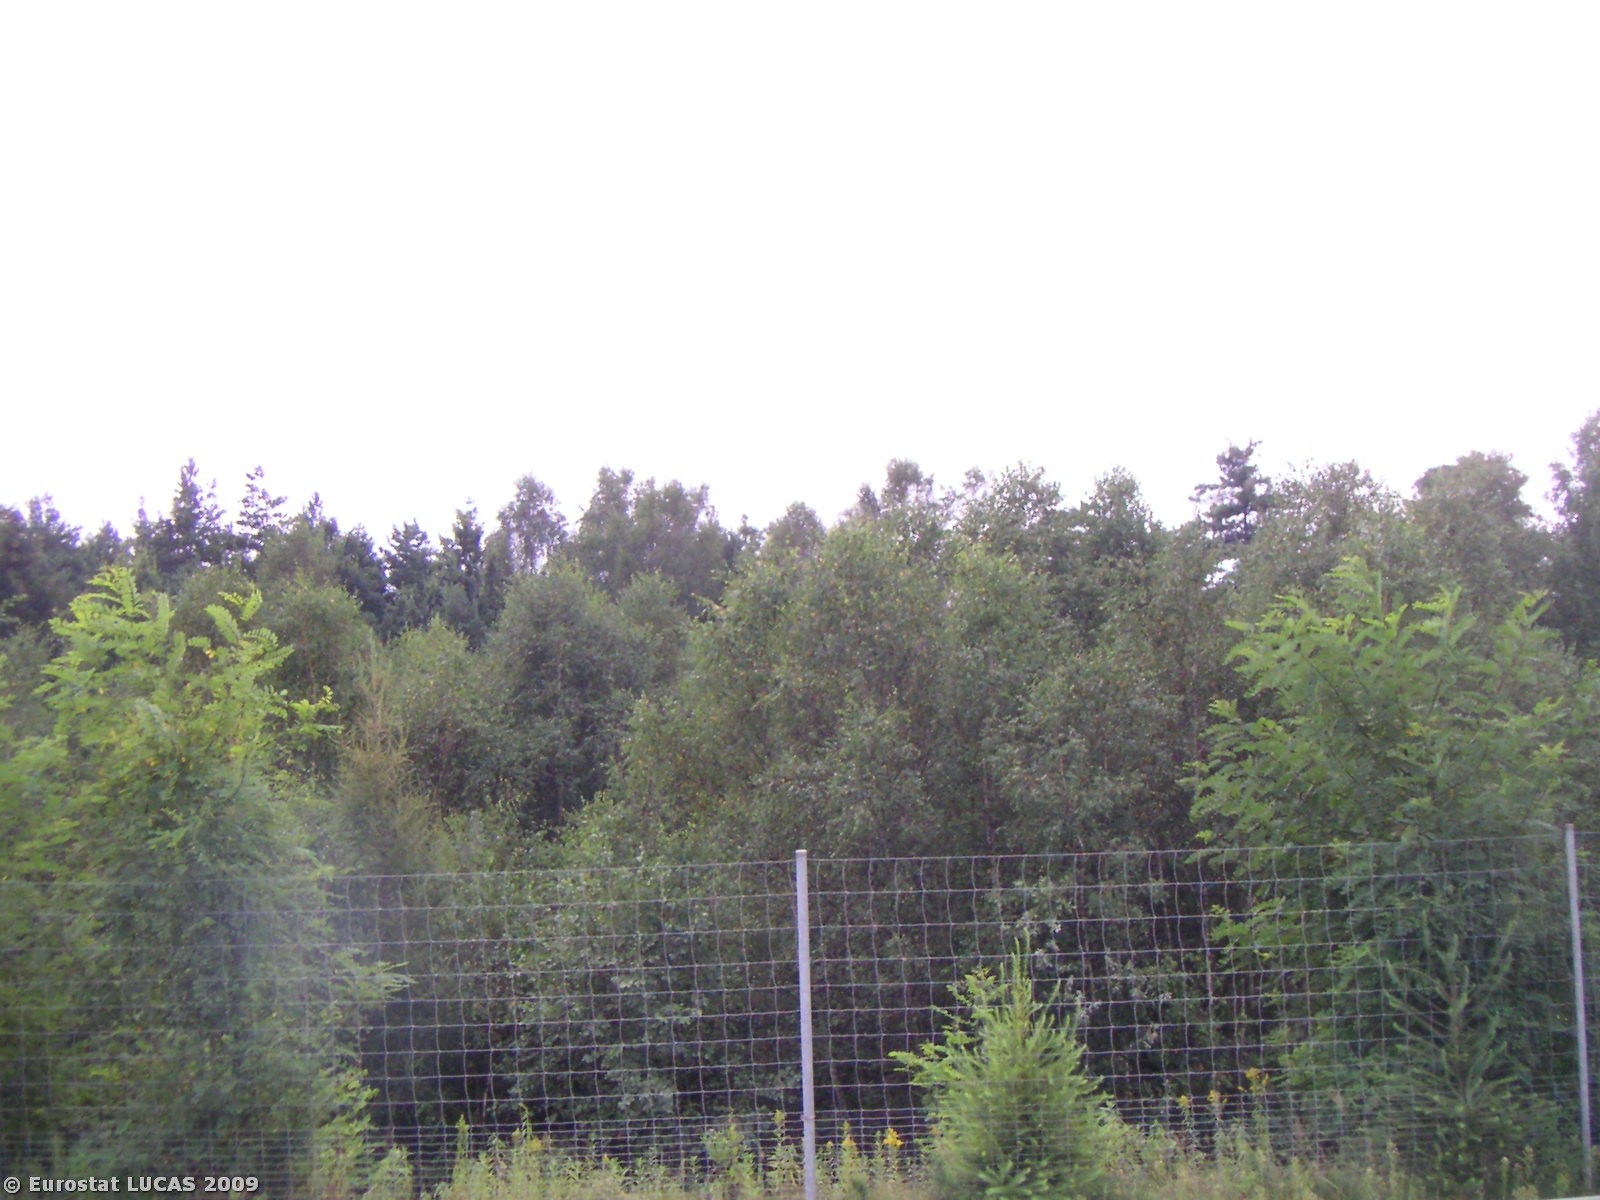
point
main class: Woodland
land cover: Mixed woodland
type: hemiboreal forest and nemoral coniferous forest and mixed broadleaved-coniferous forest
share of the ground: > 75 %
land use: Forestry
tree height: > 5 m
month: August
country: PL
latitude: 50.2583
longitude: 18.8162
